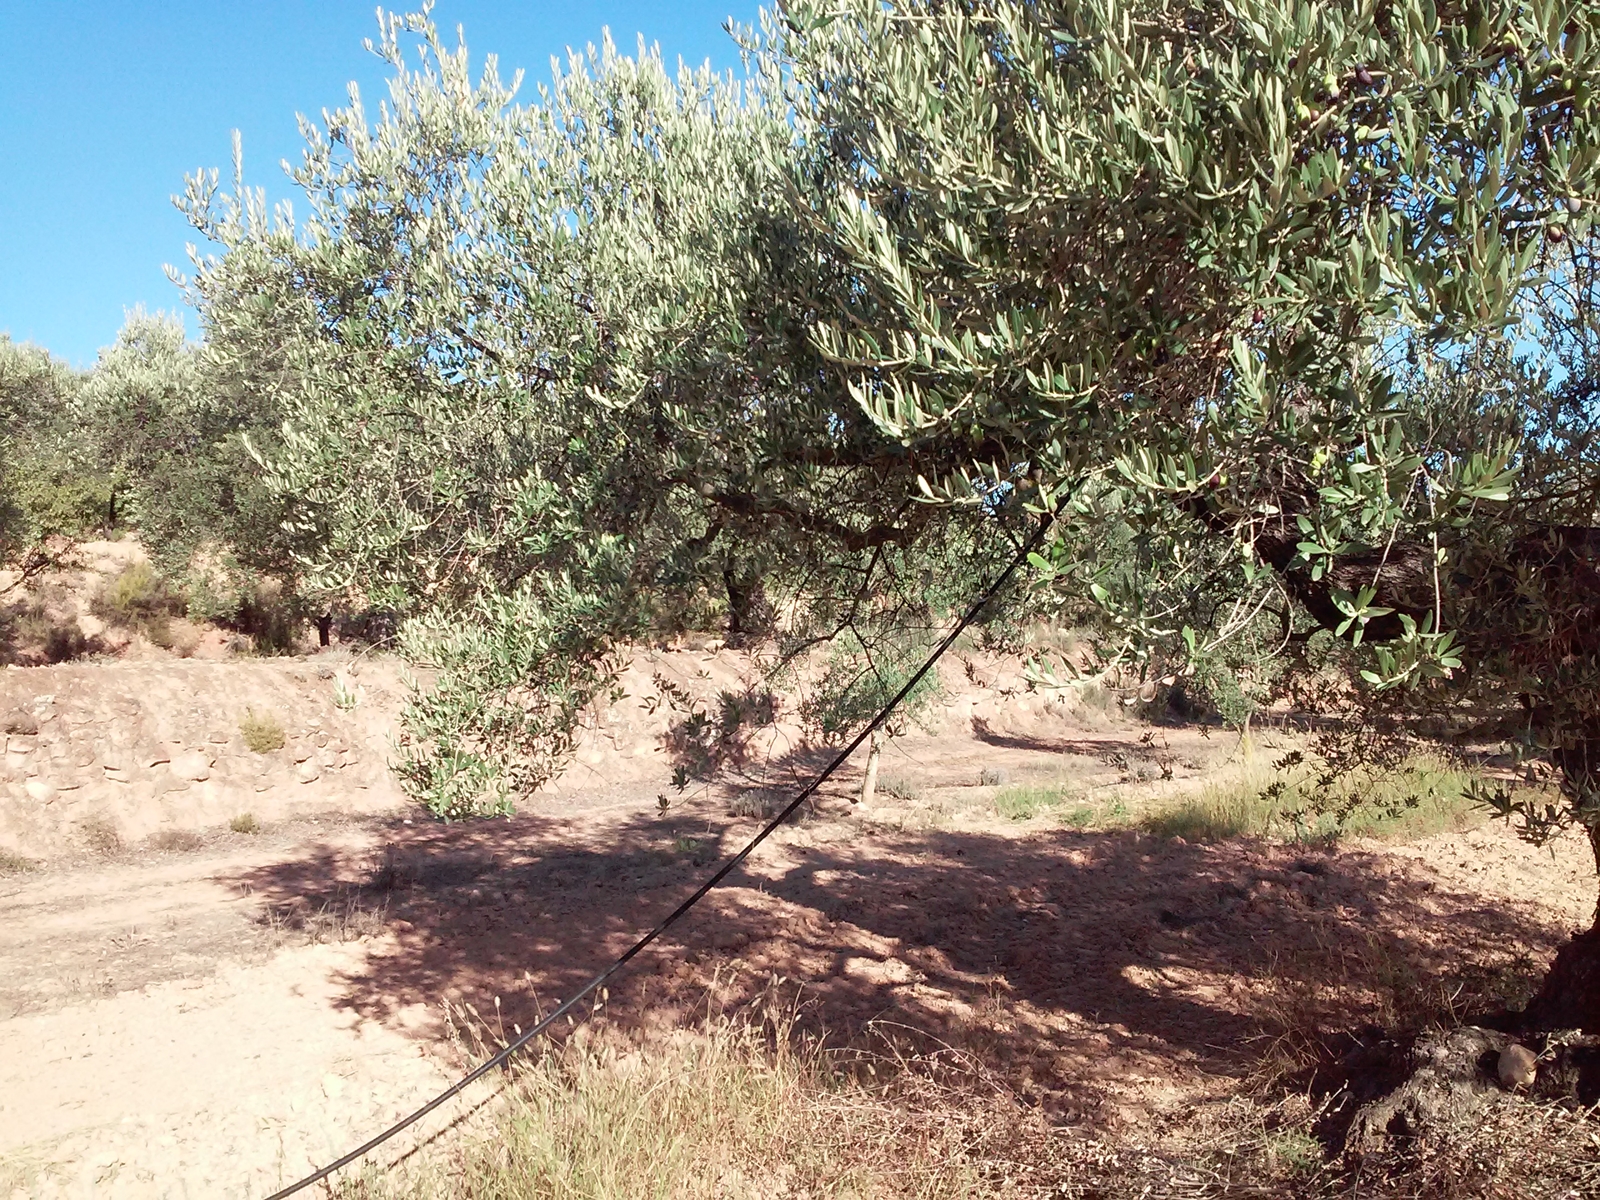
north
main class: Cropland
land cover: Olive groves
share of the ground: 25 - 50 %
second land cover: Other bare soil
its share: > 75 %
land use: Agriculture (excluding fallow land and kitchen gardens)
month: September
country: ES
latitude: 41.1919
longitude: 0.5357
